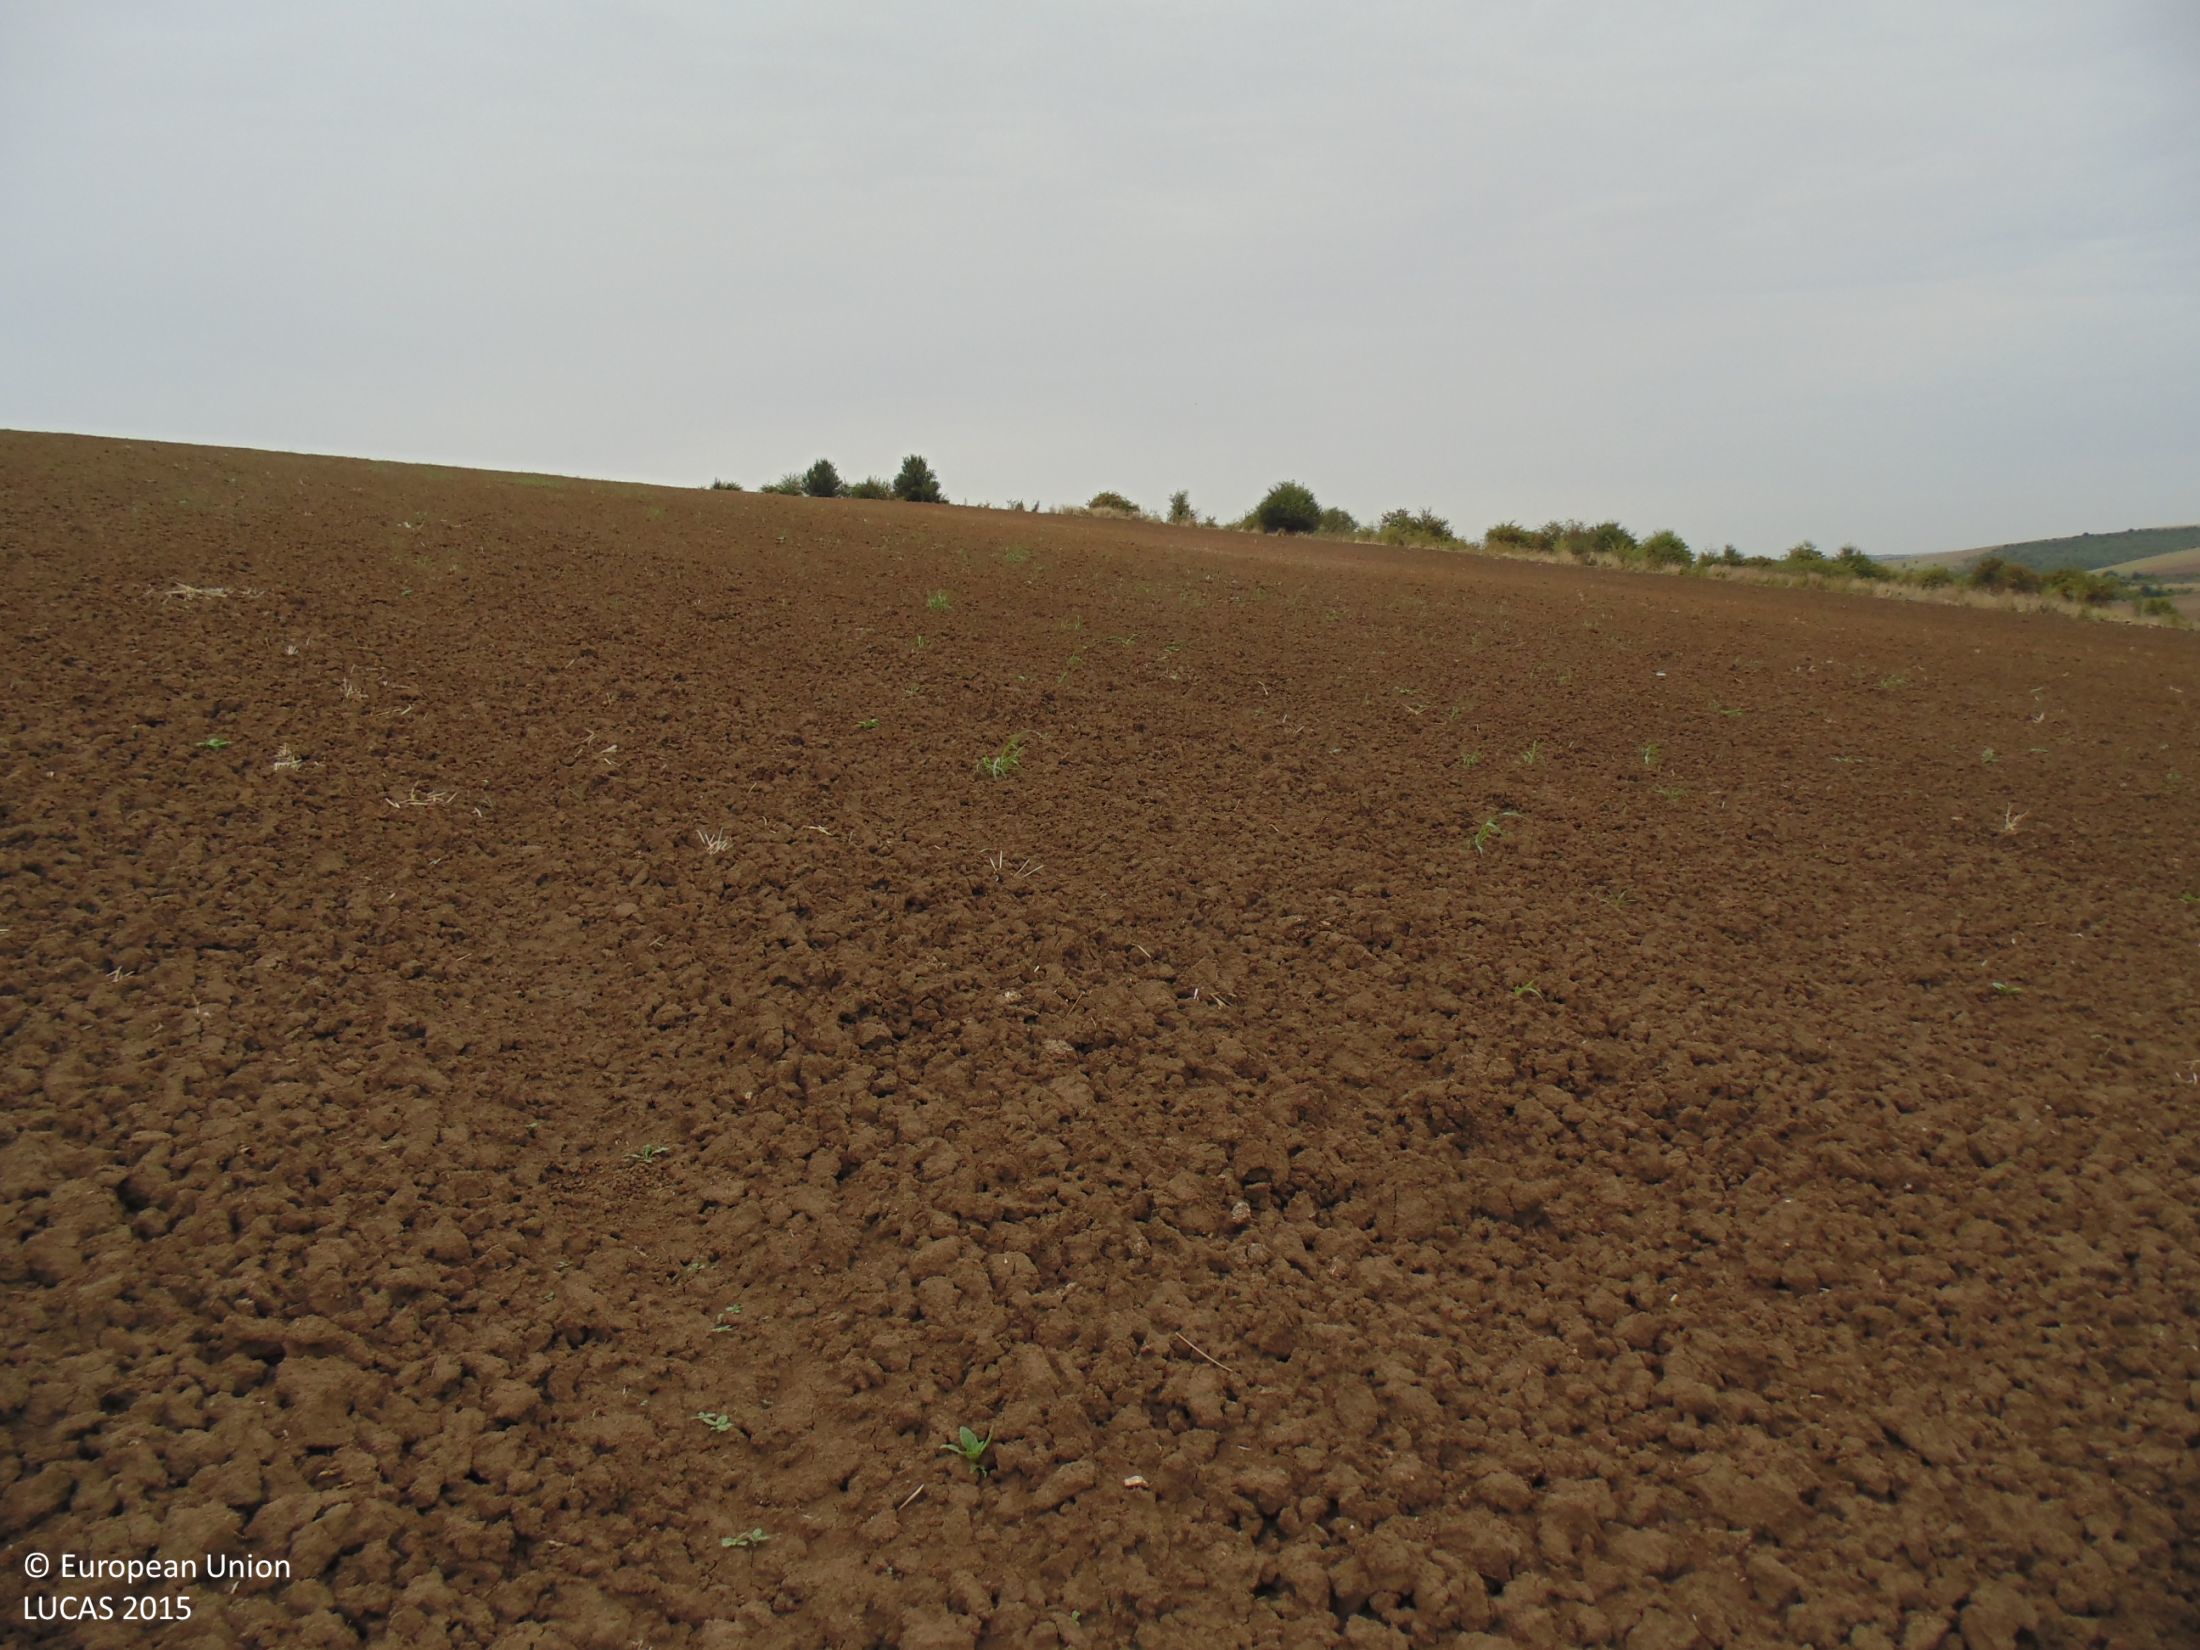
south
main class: Cropland
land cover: Common wheat
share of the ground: < 10 %
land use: Agriculture (excluding fallow land and kitchen gardens)
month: September
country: BG
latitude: 44.0258
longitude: 27.0810
